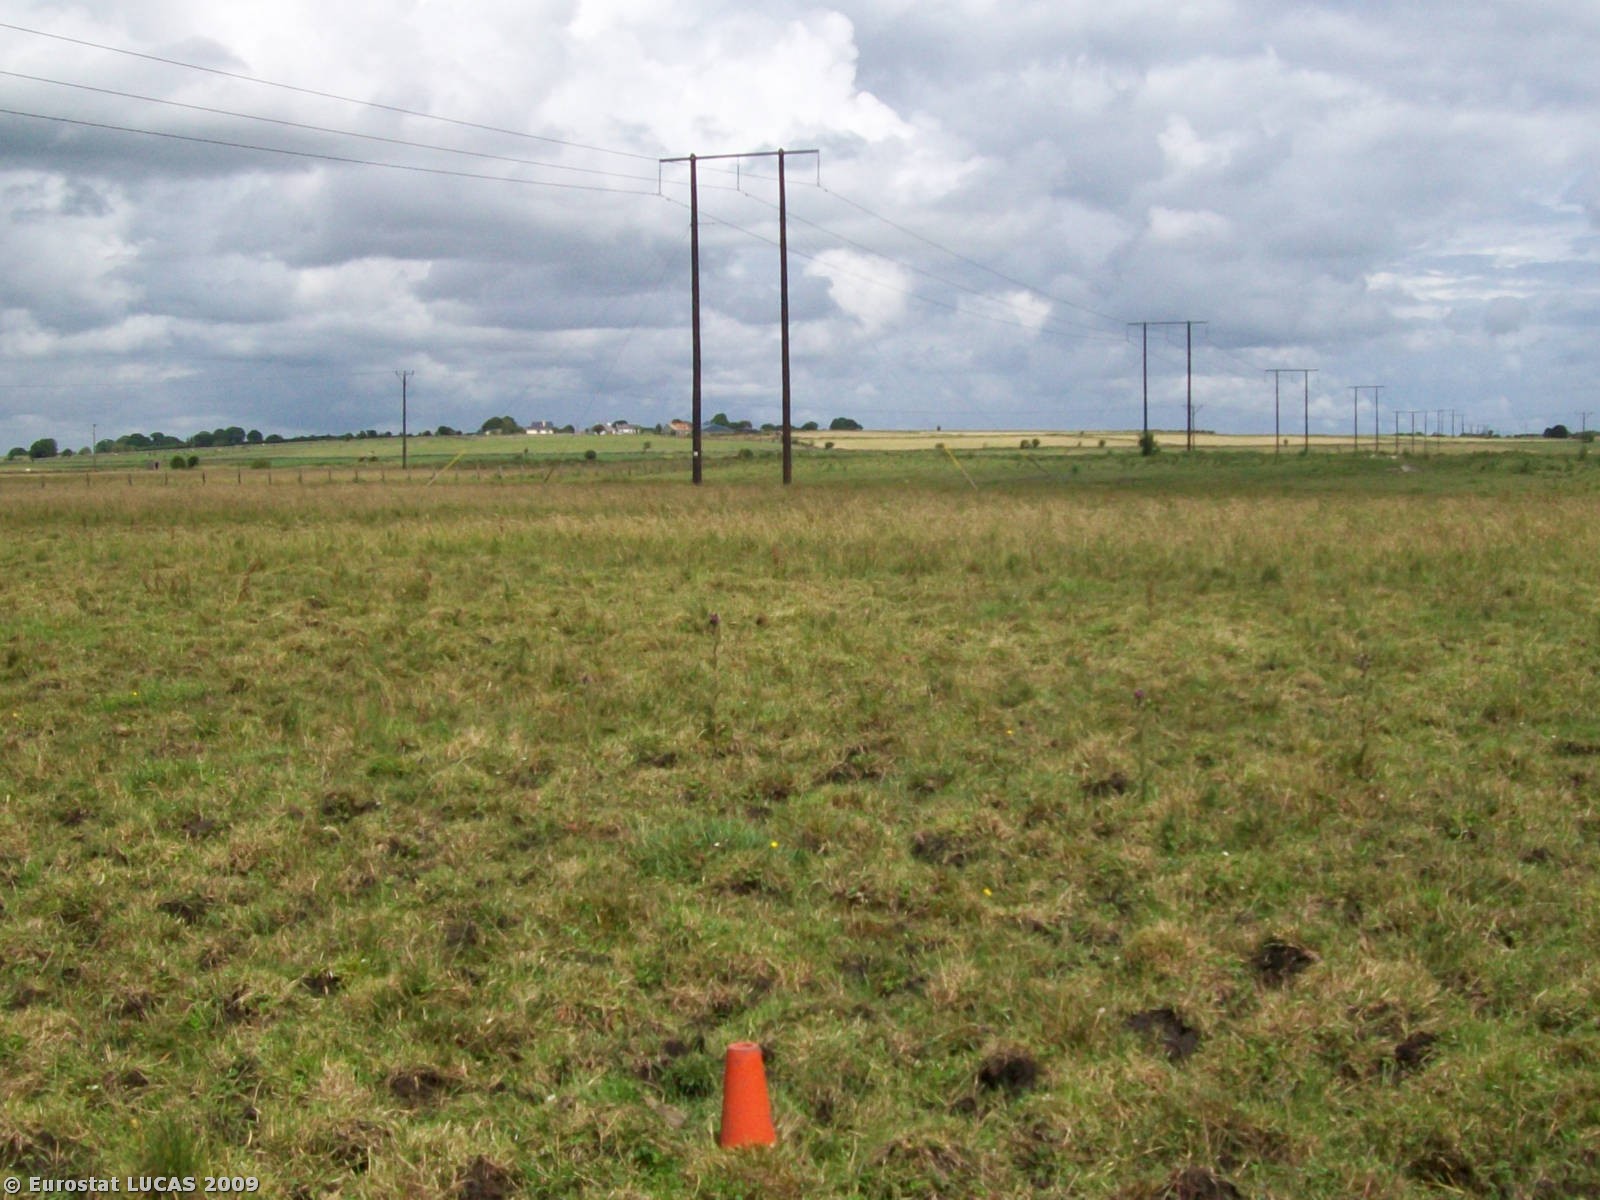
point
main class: Grassland
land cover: Grassland without tree/shrub cover
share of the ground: > 75 %
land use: Agriculture (excluding fallow land and kitchen gardens)
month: July
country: IE
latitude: 53.4701
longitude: -8.8728
